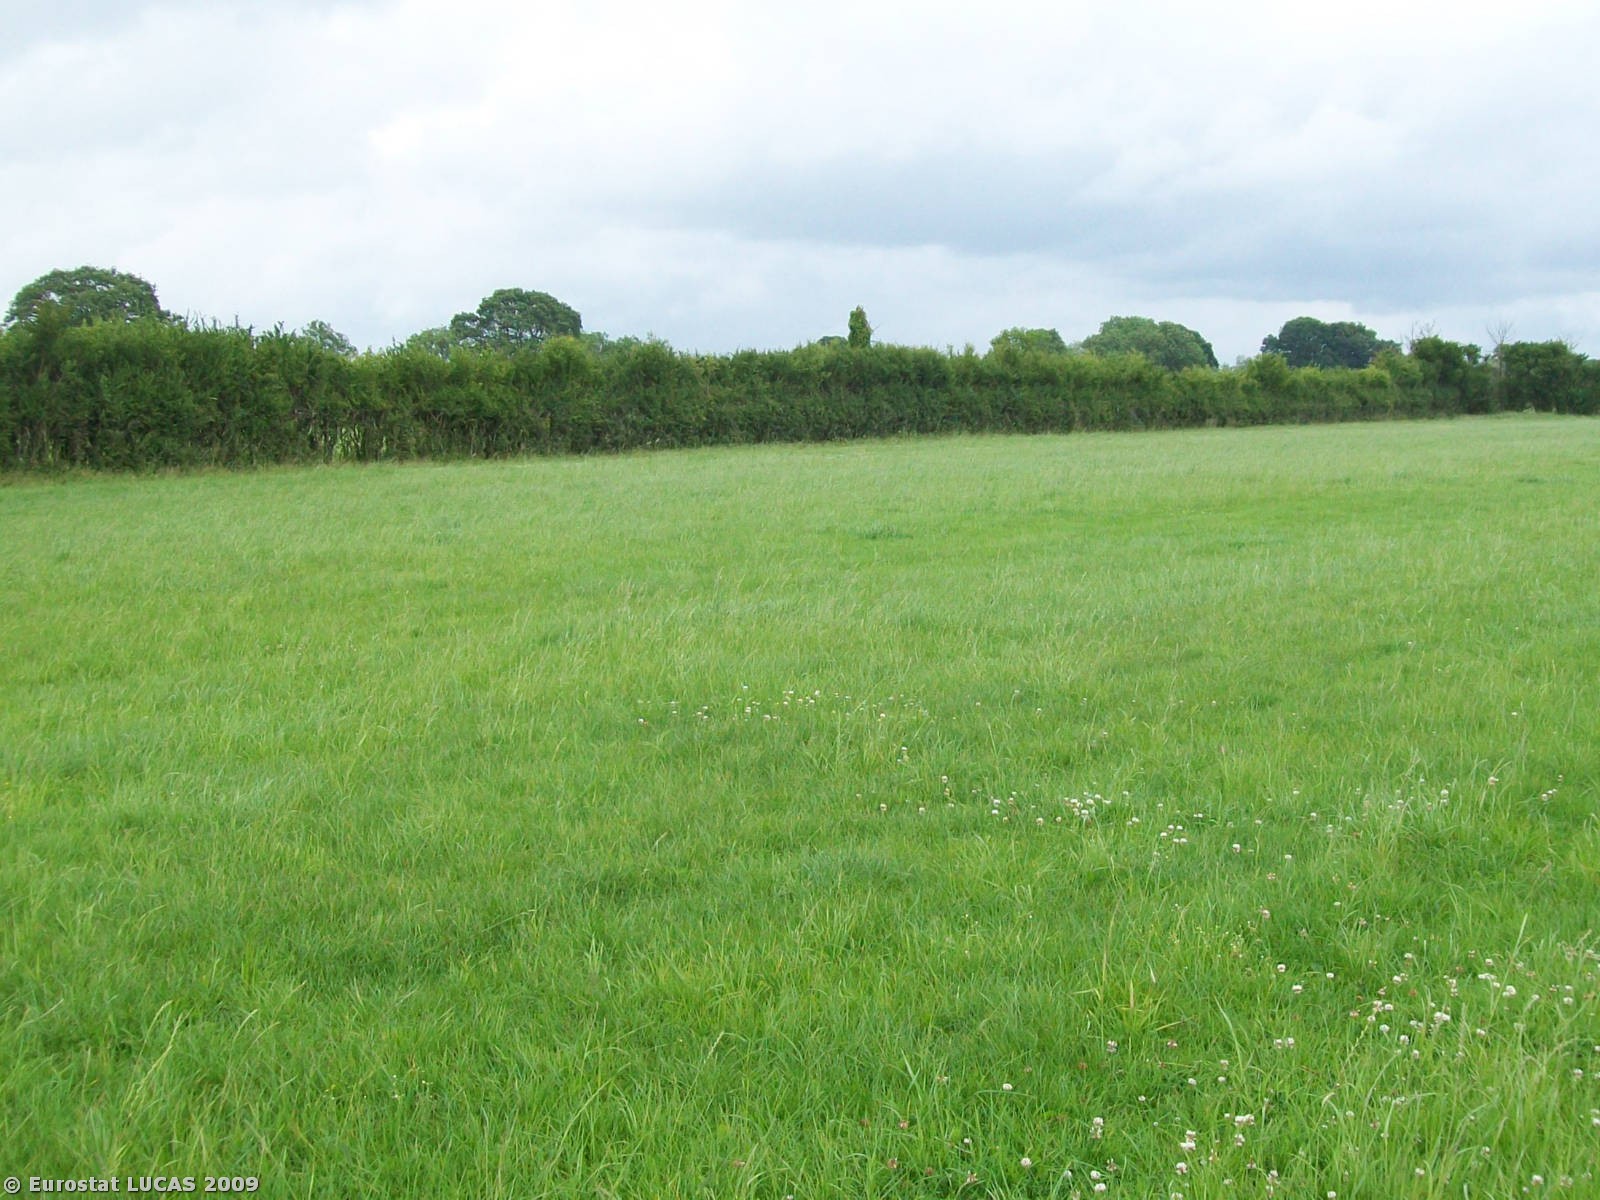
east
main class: Grassland
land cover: Grassland without tree/shrub cover
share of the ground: > 75 %
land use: Agriculture (excluding fallow land and kitchen gardens)
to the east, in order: Grassland without tree/shrub cover; Managed hedges; Grassland without tree/shrub cover; Ditches and canals; Grassland without tree/shrub cover
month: July
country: GB
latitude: 51.0072
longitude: -2.7983
